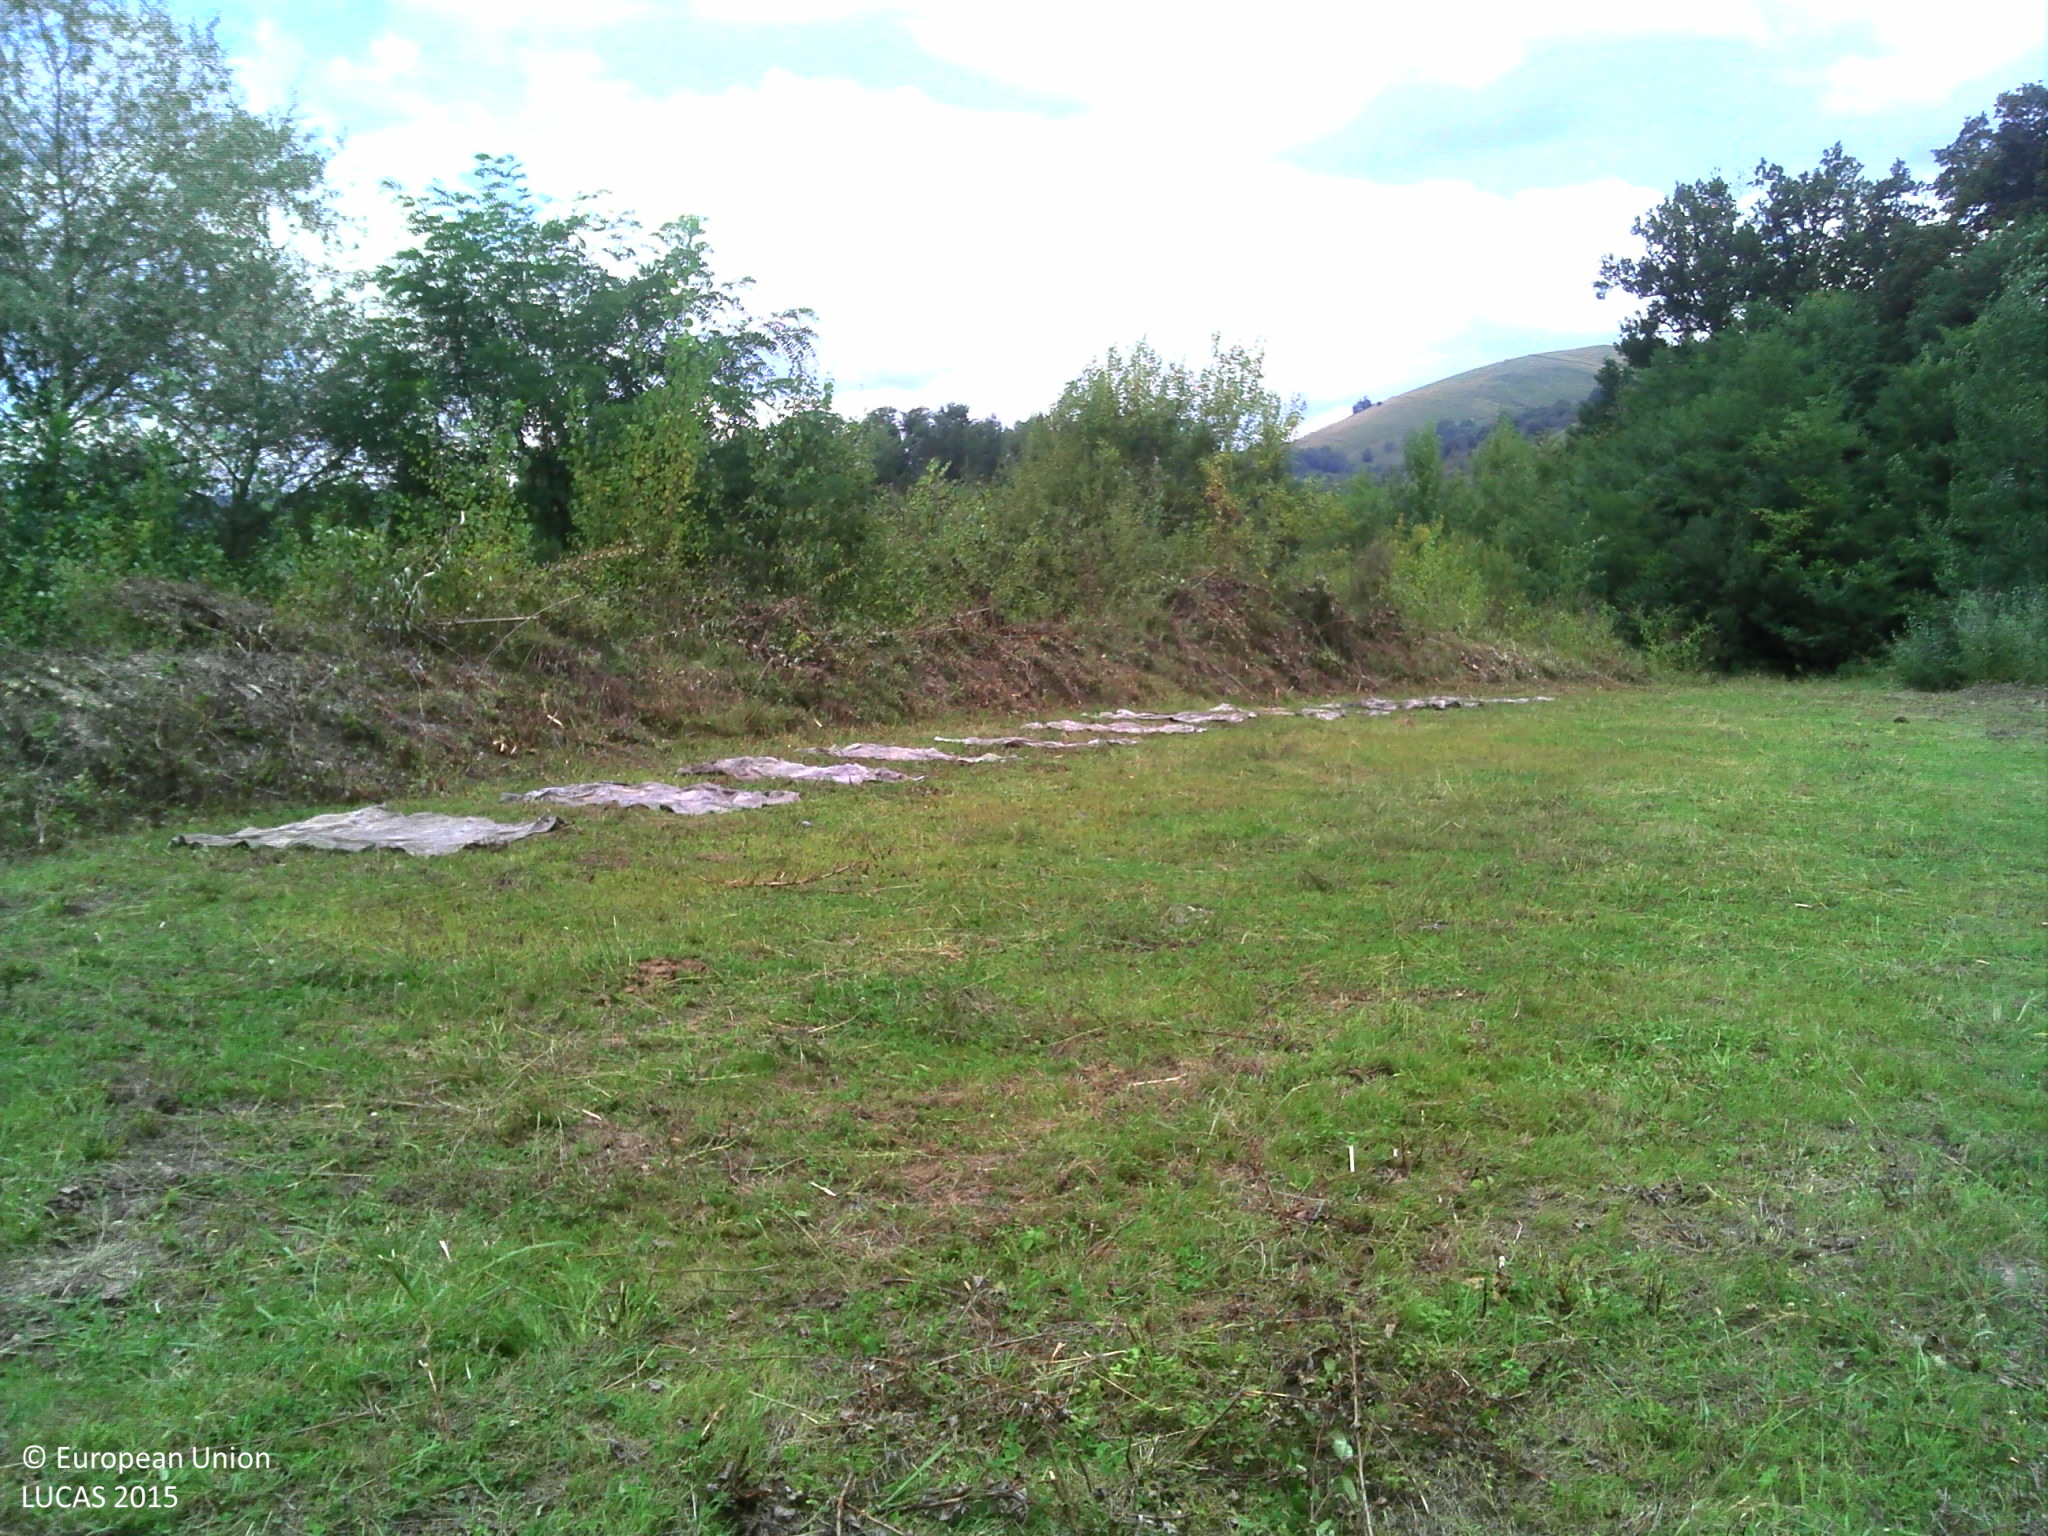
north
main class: Grassland
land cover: Grassland without tree/shrub cover
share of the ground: > 75 %
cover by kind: herbaceous plants 80 %, unconsolidated bare surface 15 %, shrubs 5 %
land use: Agriculture (excluding fallow land and kitchen gardens)
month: September
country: FR
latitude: 43.1746
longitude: -0.8972
